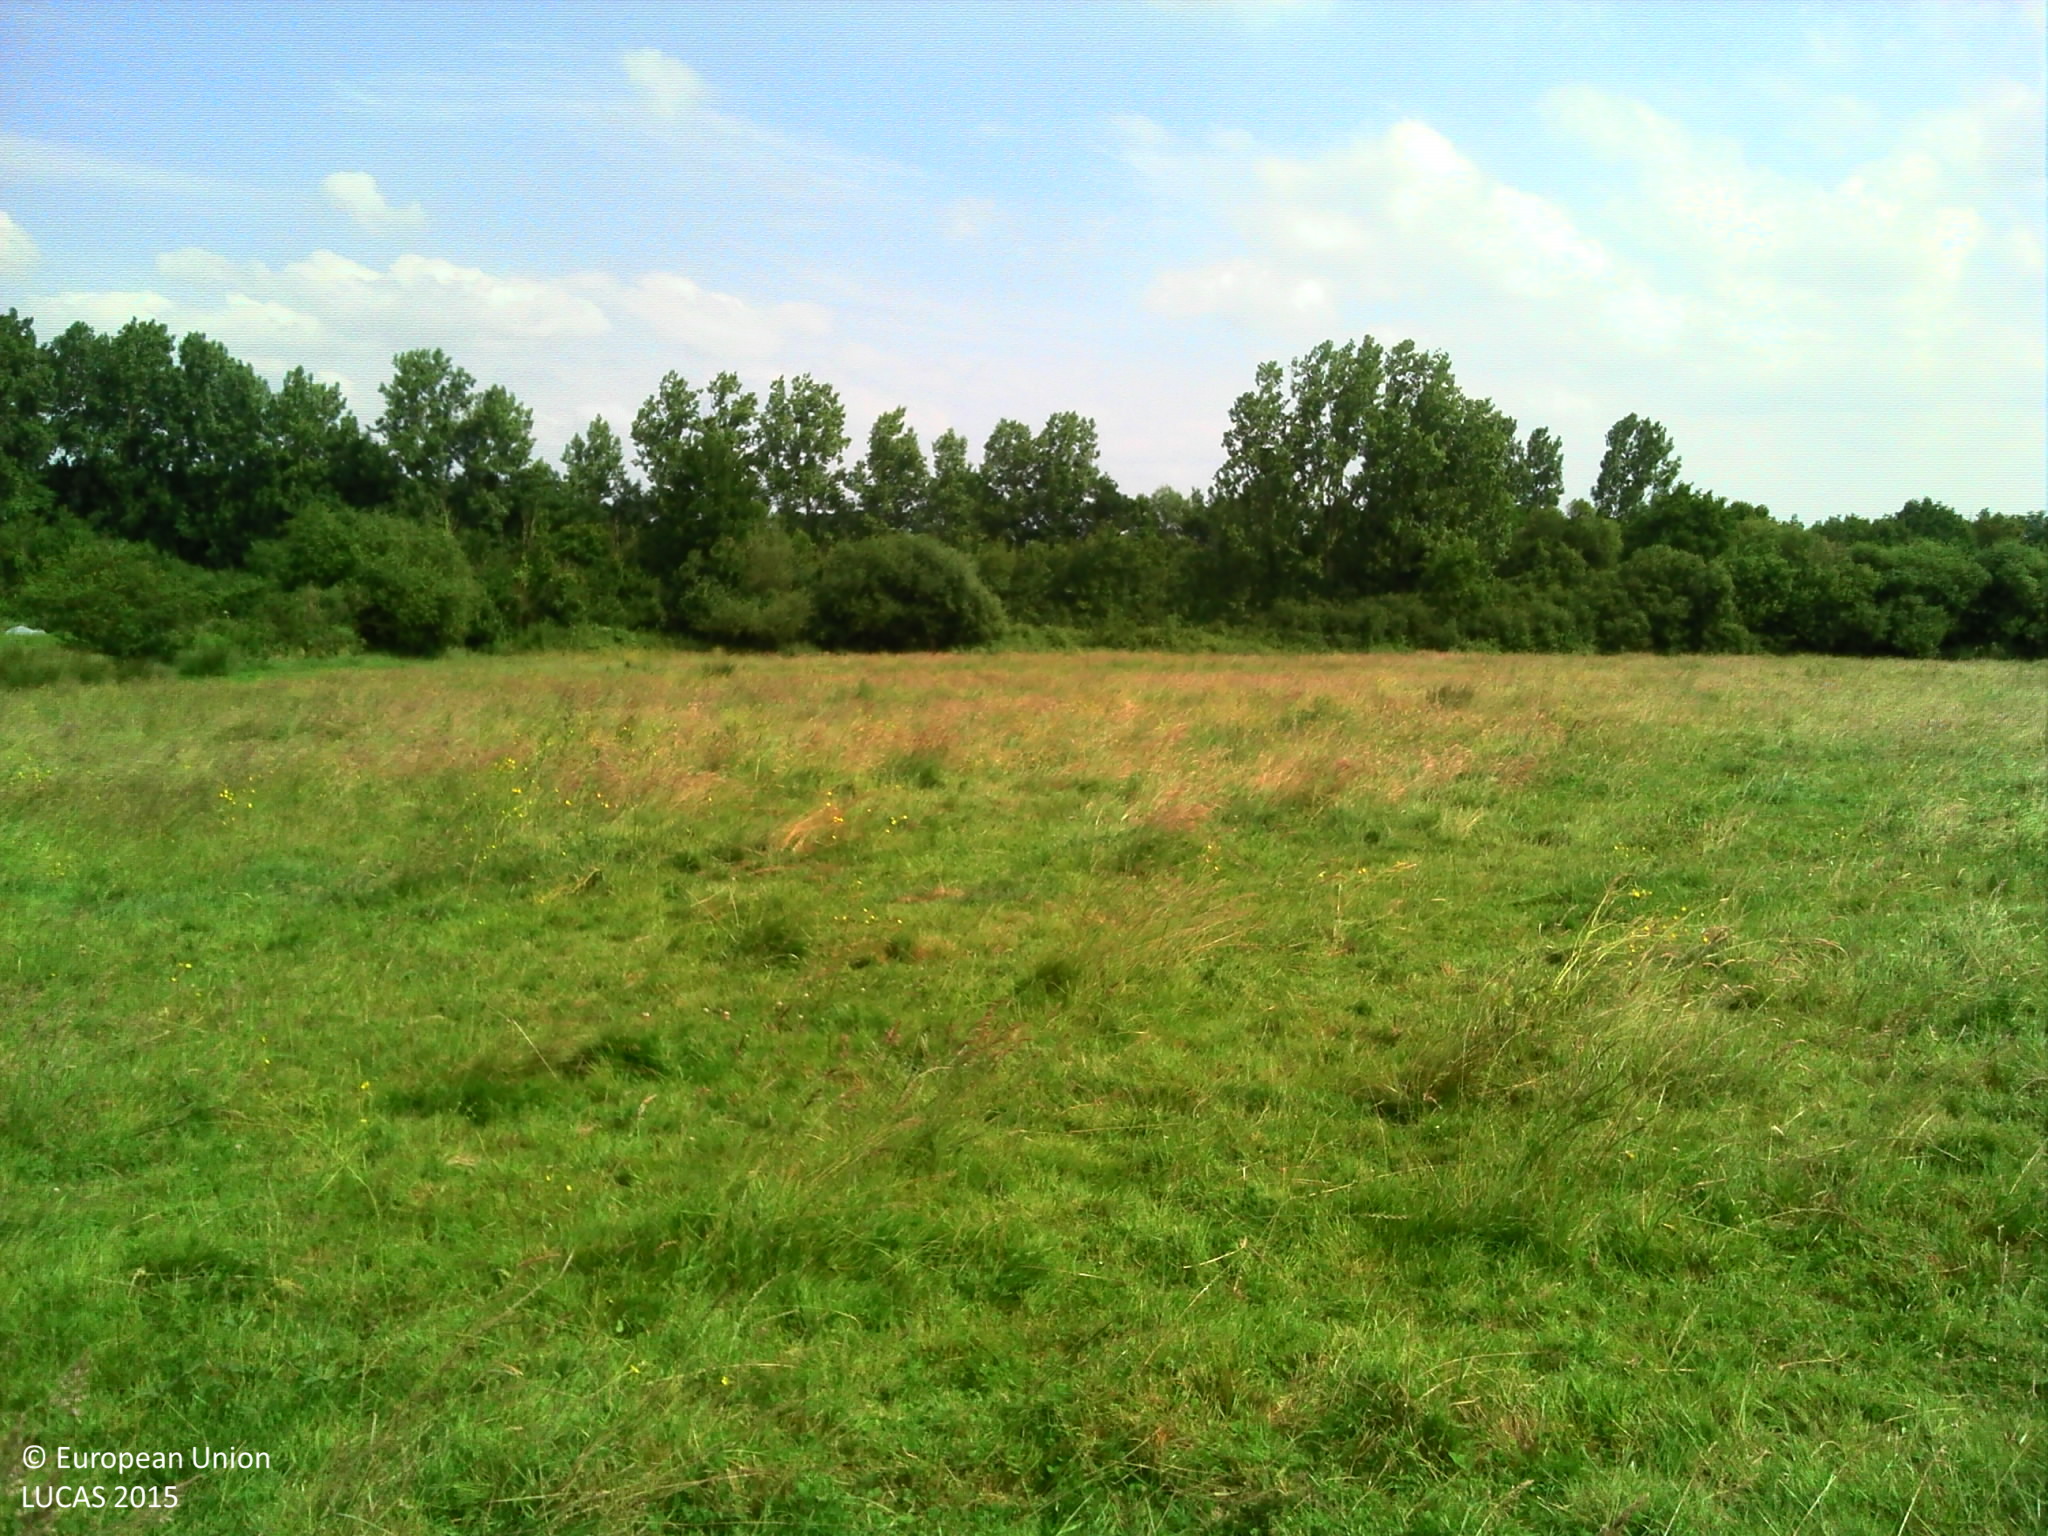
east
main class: Grassland
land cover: Grassland without tree/shrub cover
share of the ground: > 75 %
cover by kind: herbaceous plants 100 %
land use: Agriculture (excluding fallow land and kitchen gardens)
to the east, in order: Grassland without tree/shrub cover; Fences; Inland fresh water bodies; Grassland without tree/shrub cover; Dry stone walls; Grassland without tree/shrub cover; Artificial constructions in urban areas
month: June
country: FR
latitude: 46.7871
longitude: -1.6339
